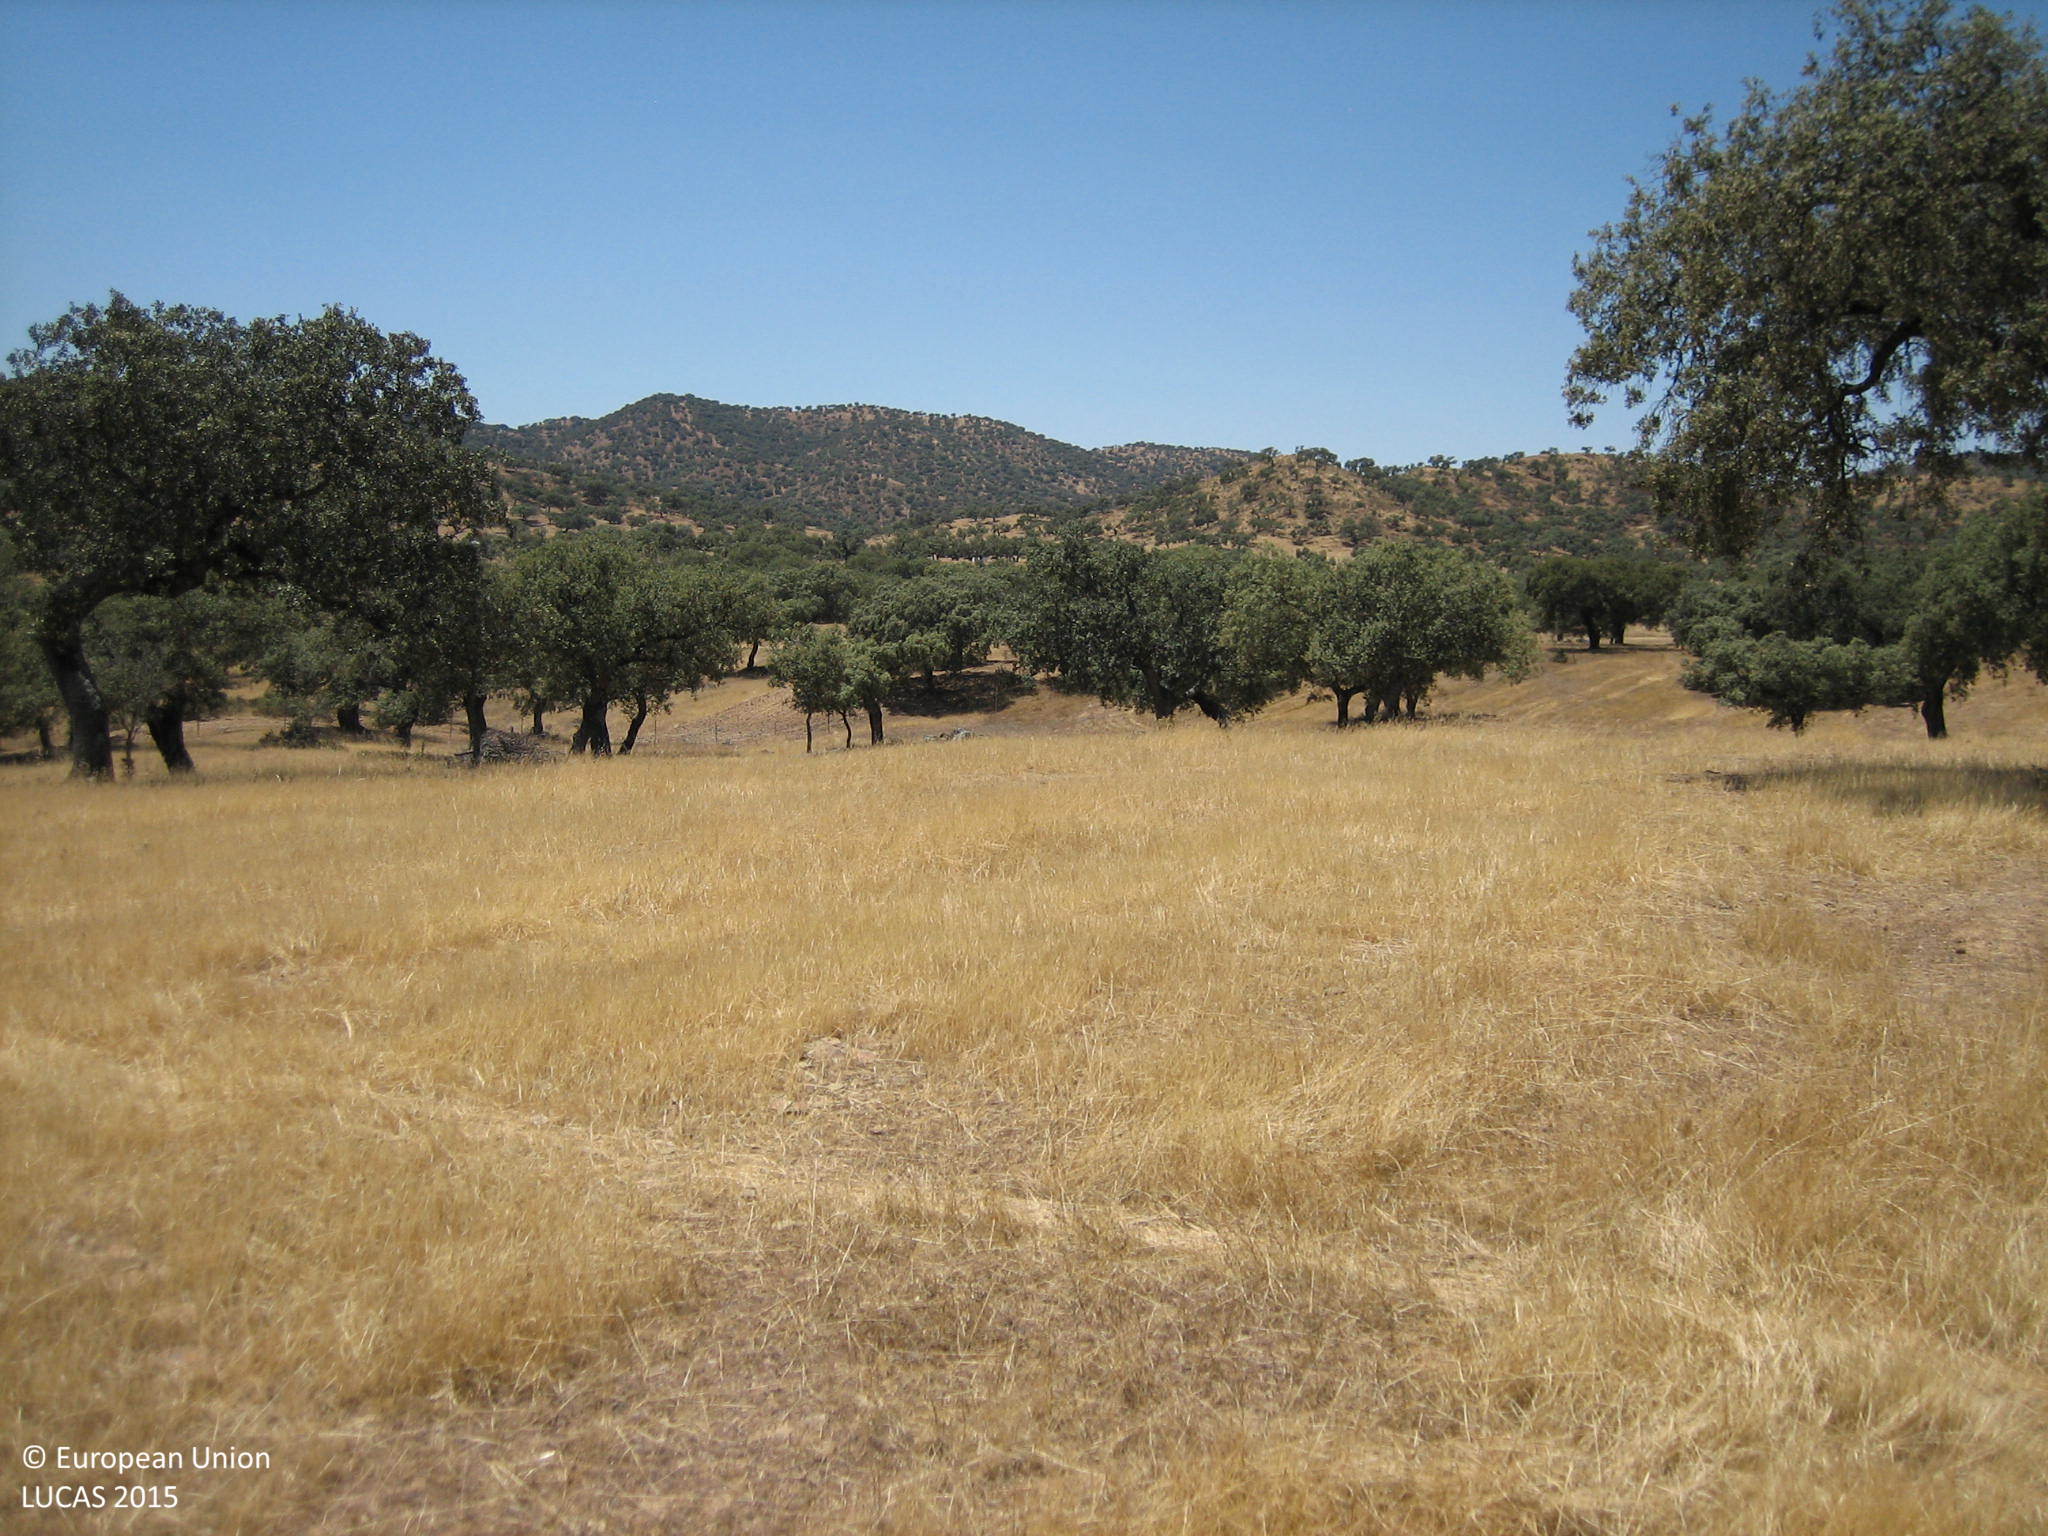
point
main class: Woodland
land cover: Broadleaved woodland
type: broadleaved evergreen forest
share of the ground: 10 - 25 %
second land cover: Grassland without tree/shrub cover
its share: > 75 %
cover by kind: herbaceous plants 90 %, broadleaved forest trees 10 %
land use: Forestry
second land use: Agriculture (excluding fallow land and kitchen gardens)
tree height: > 5 m
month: July
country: ES
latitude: 38.1764
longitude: -6.0783
